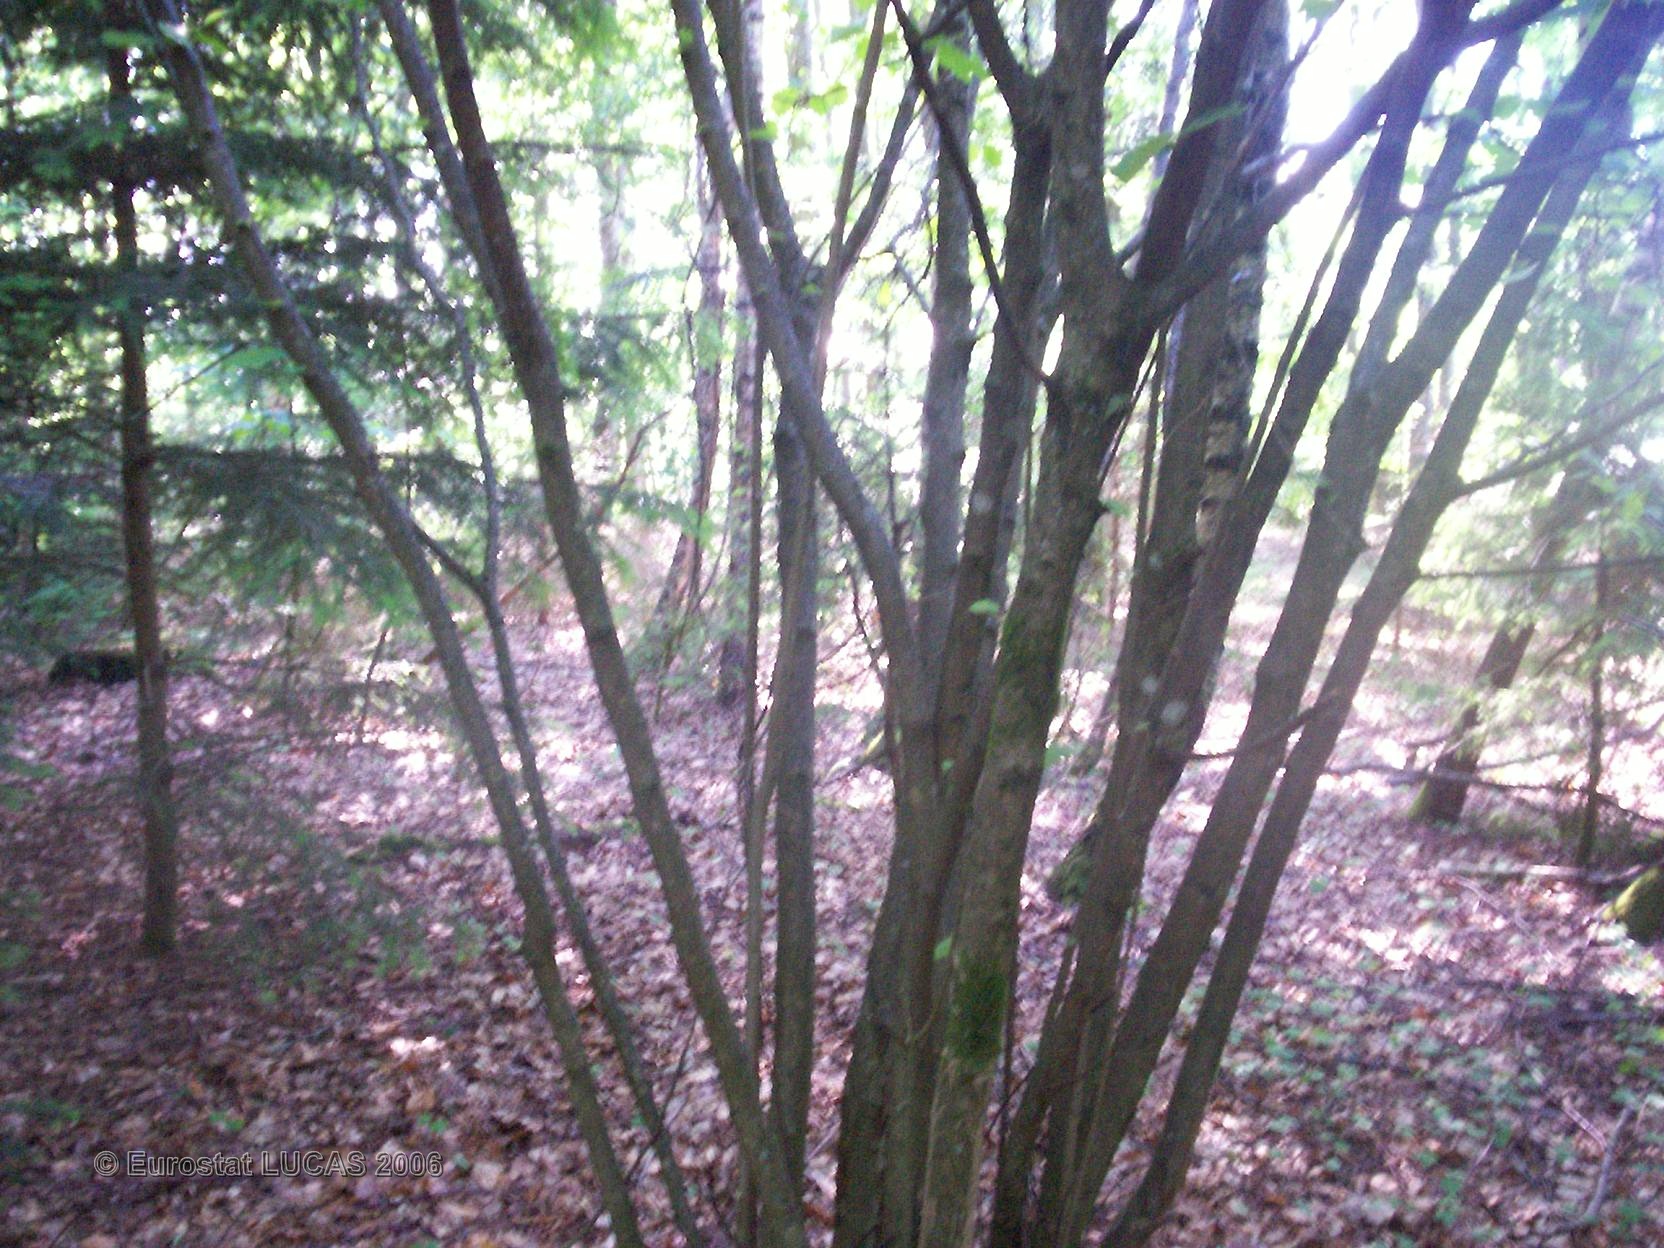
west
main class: Woodland
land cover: Coniferous forest
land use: Forestry
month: June
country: FR
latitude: 48.3274
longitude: 7.0200
